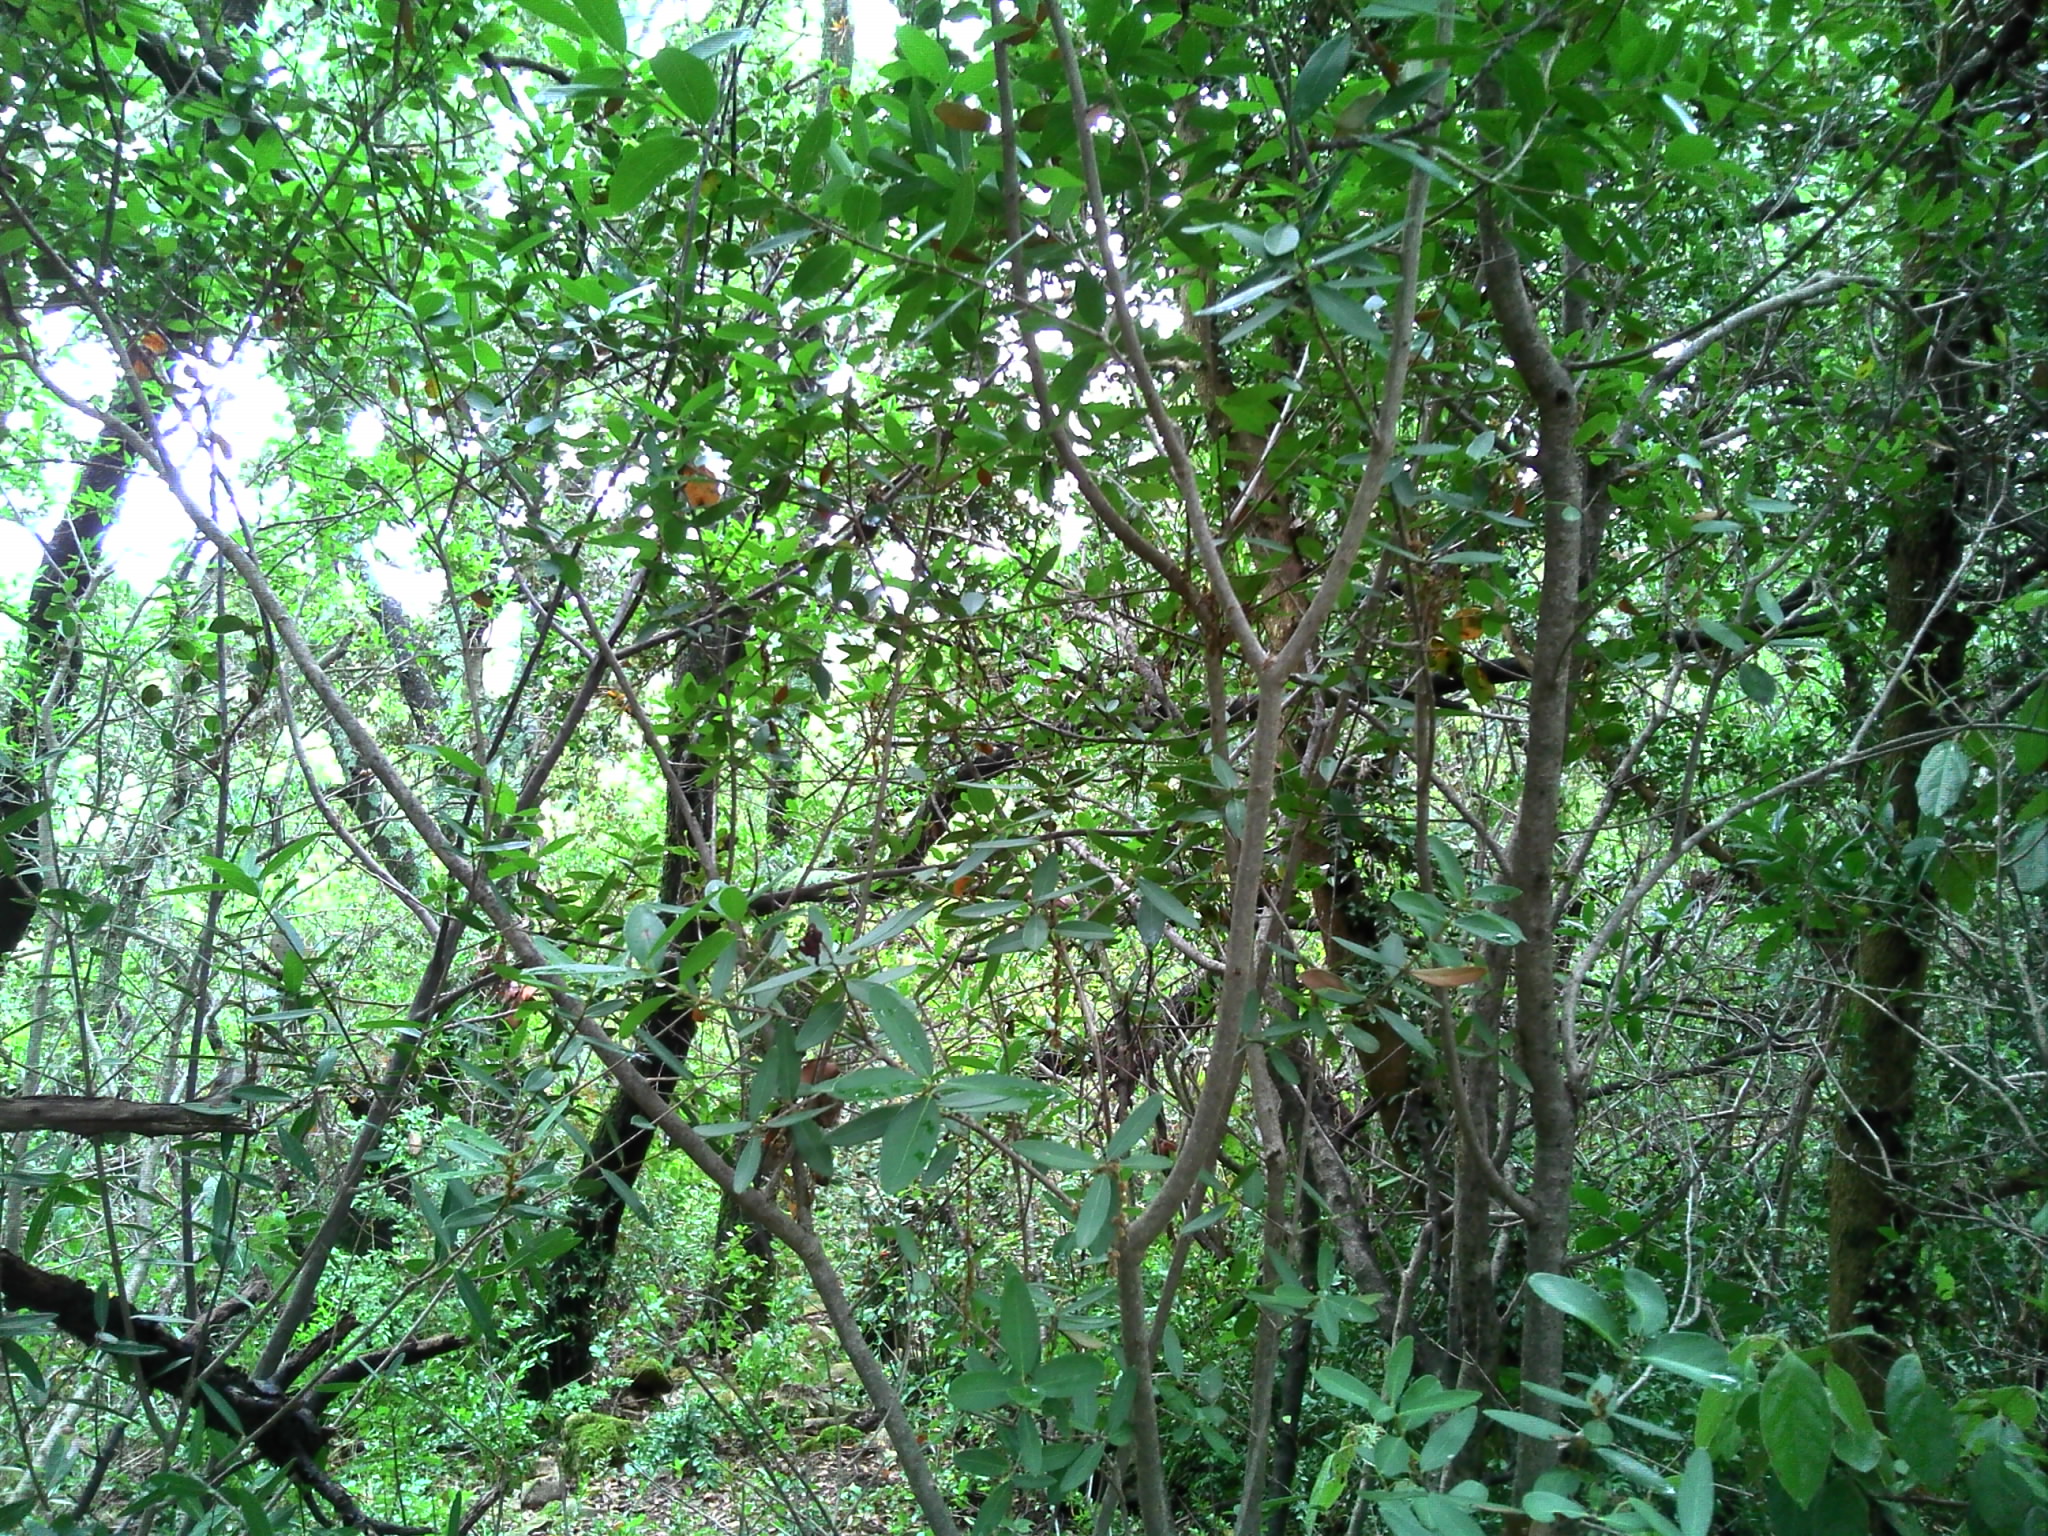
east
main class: Woodland
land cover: Broadleaved woodland
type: broadleaved evergreen forest
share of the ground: > 75 %
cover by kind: broadleaved forest trees 60 %, consolidated bare surface 20 %, shrubs 10 %, herbaceous plants 10 %
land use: Semi-natural and natural areas not in use
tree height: > 5 m
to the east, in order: Broadleaved woodland
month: August
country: FR
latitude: 44.1220
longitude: 4.6470
